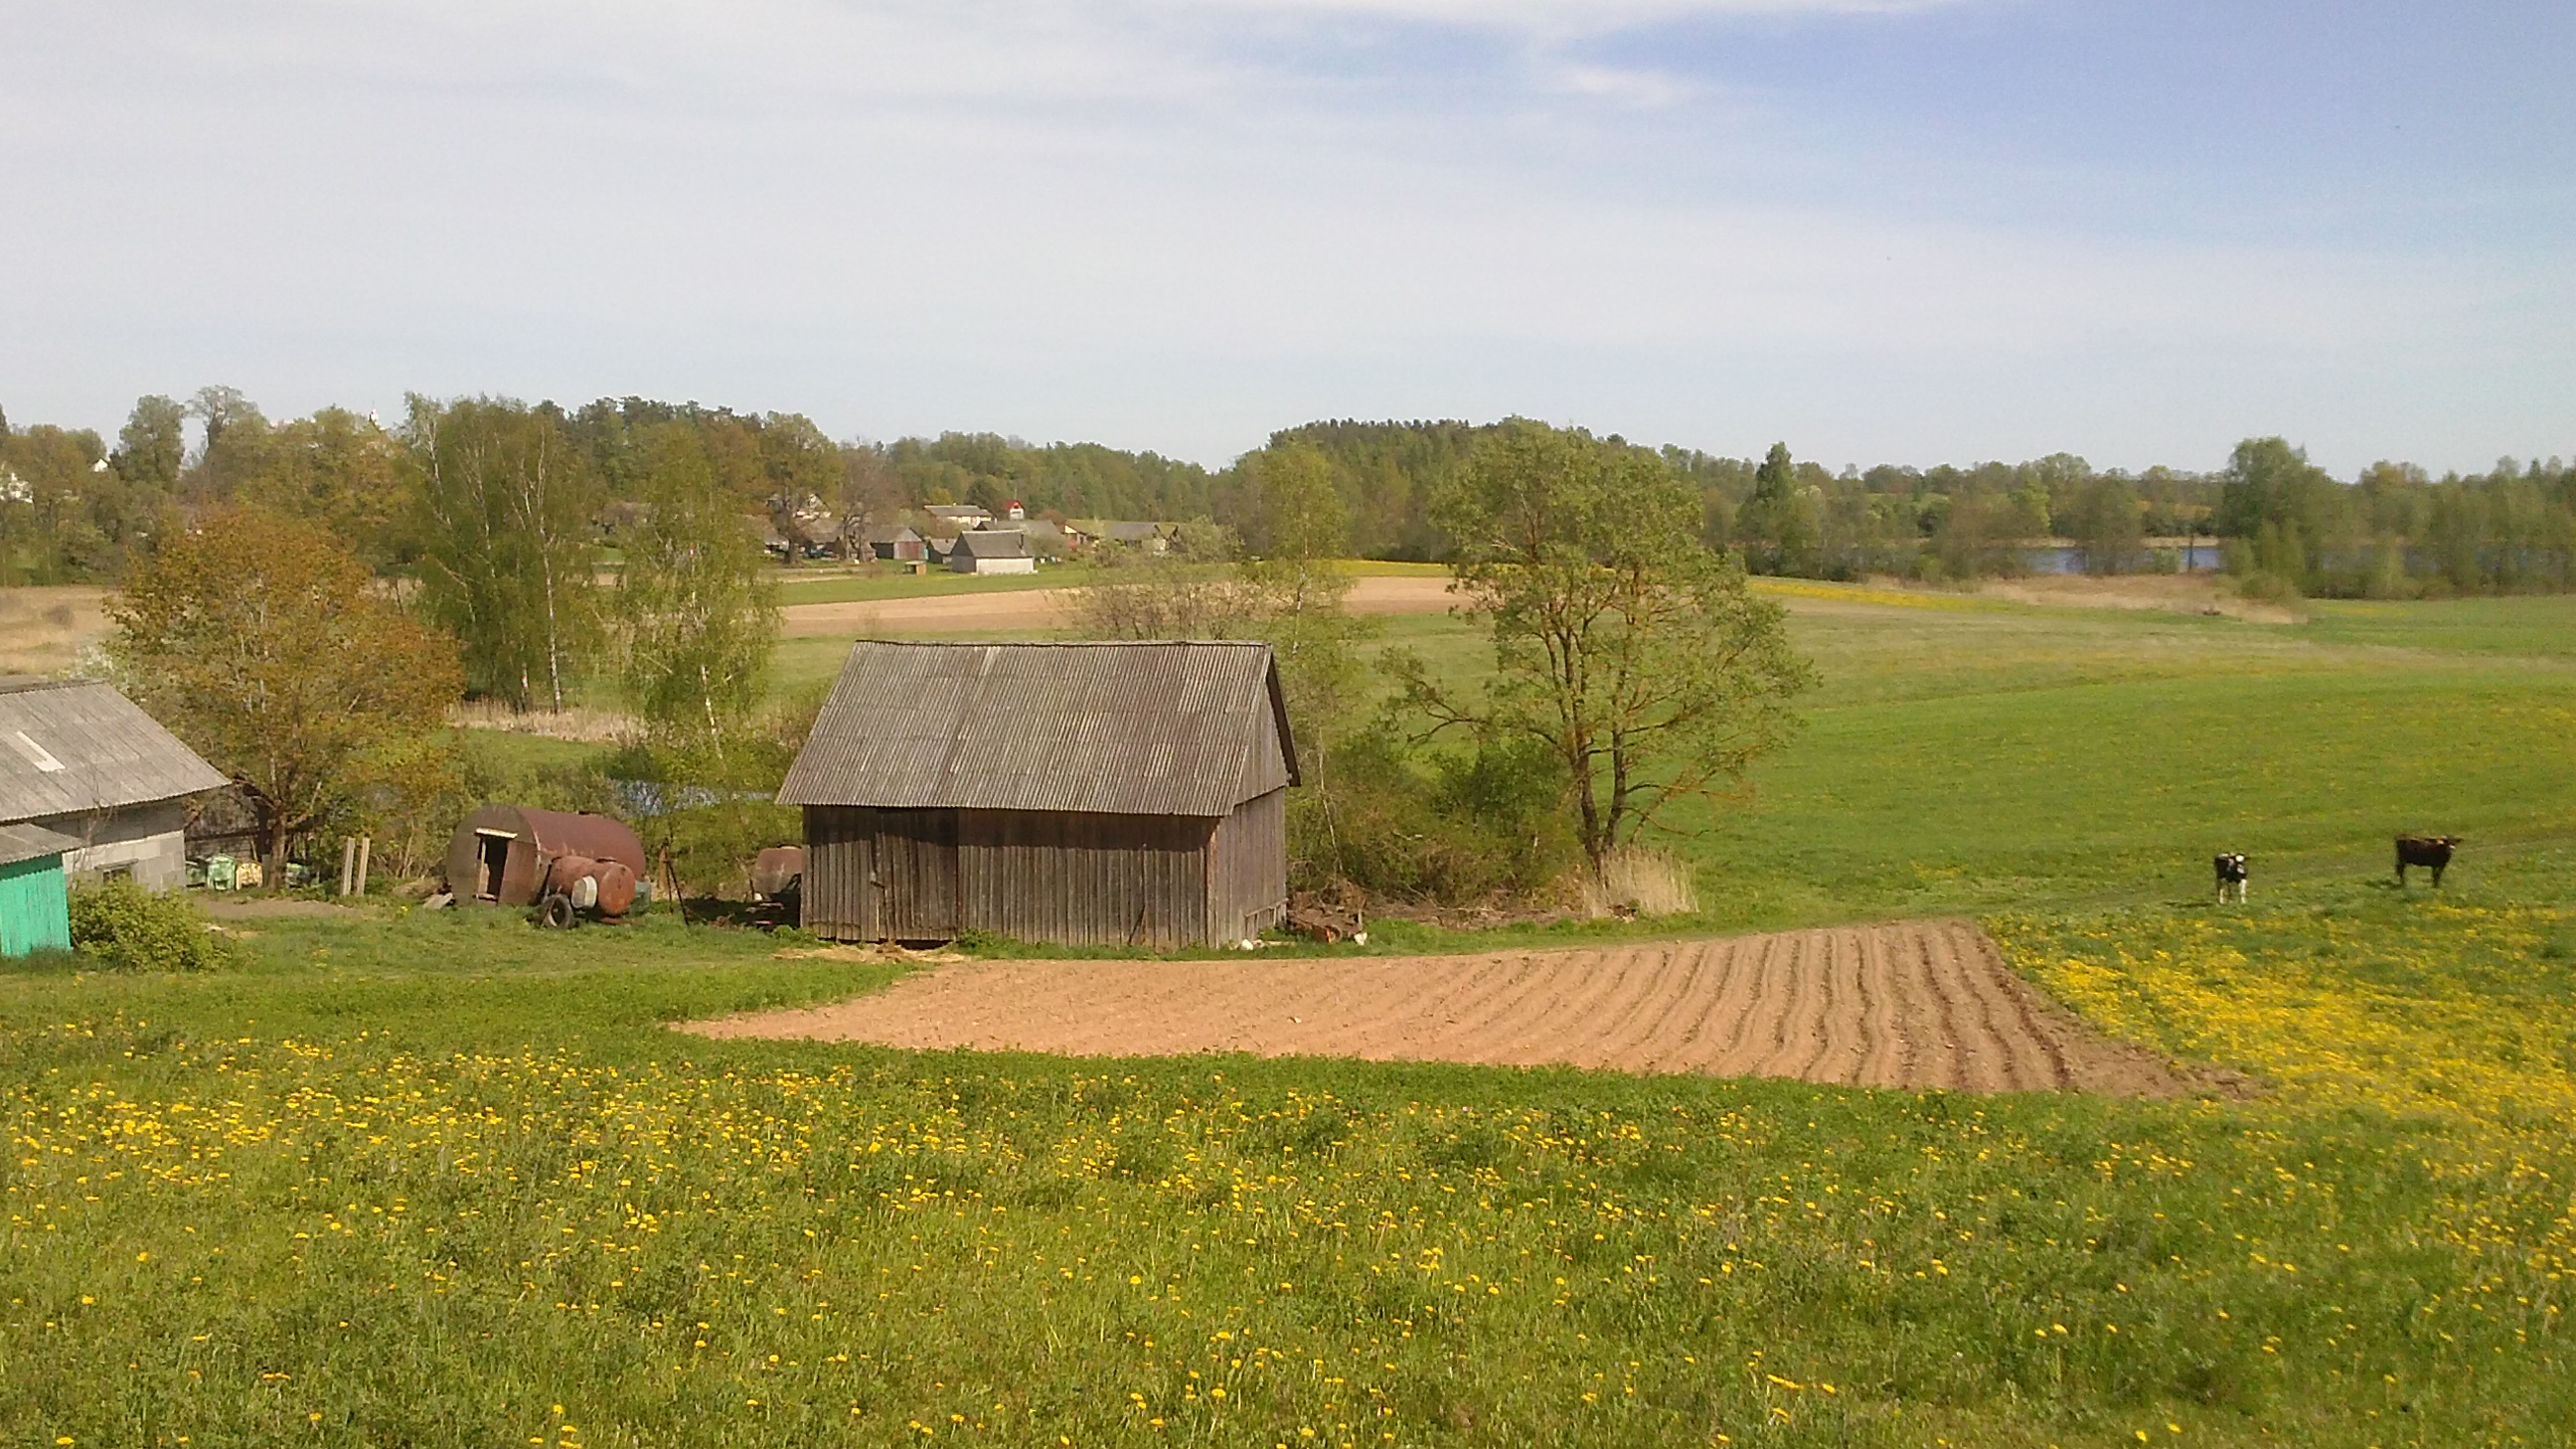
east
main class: Grassland
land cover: Grassland without tree/shrub cover
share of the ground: > 75 %
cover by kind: herbaceous plants 100 %
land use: Agriculture (excluding fallow land and kitchen gardens)
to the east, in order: Grassland without tree/shrub cover; Ditches and canals; Grassland without tree/shrub cover; Inland fresh water bodies; Grassland without tree/shrub cover; Broadleaved woodland; Grassland without tree/shrub cover; Artificial constructions in urban areas; Broadleaved woodland; Paved roads, cycling and walking lanes; Grassland without tree/shrub cover; Electric lines; Oats
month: May
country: LV
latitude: 55.9712
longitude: 27.6020
